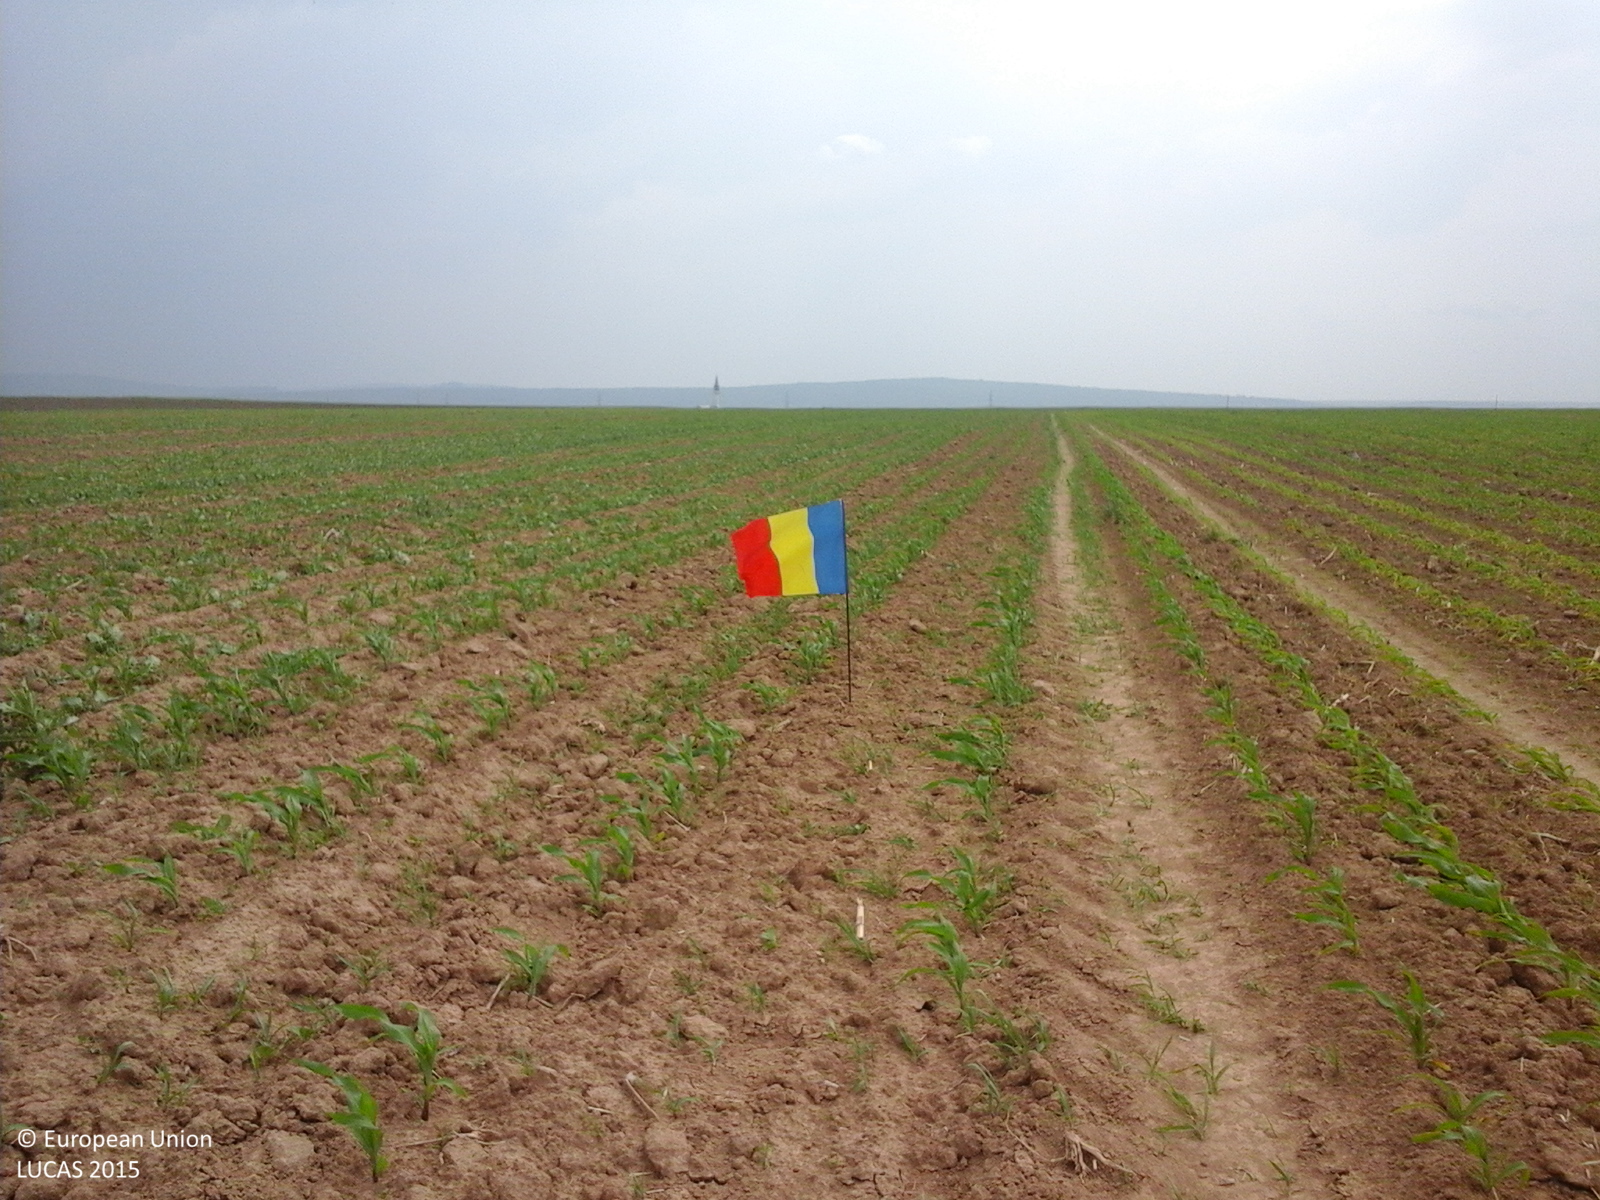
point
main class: Cropland
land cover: Maize
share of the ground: 25 - 50 %
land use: Agriculture (excluding fallow land and kitchen gardens)
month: June
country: RO
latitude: 47.0938
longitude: 26.7587
